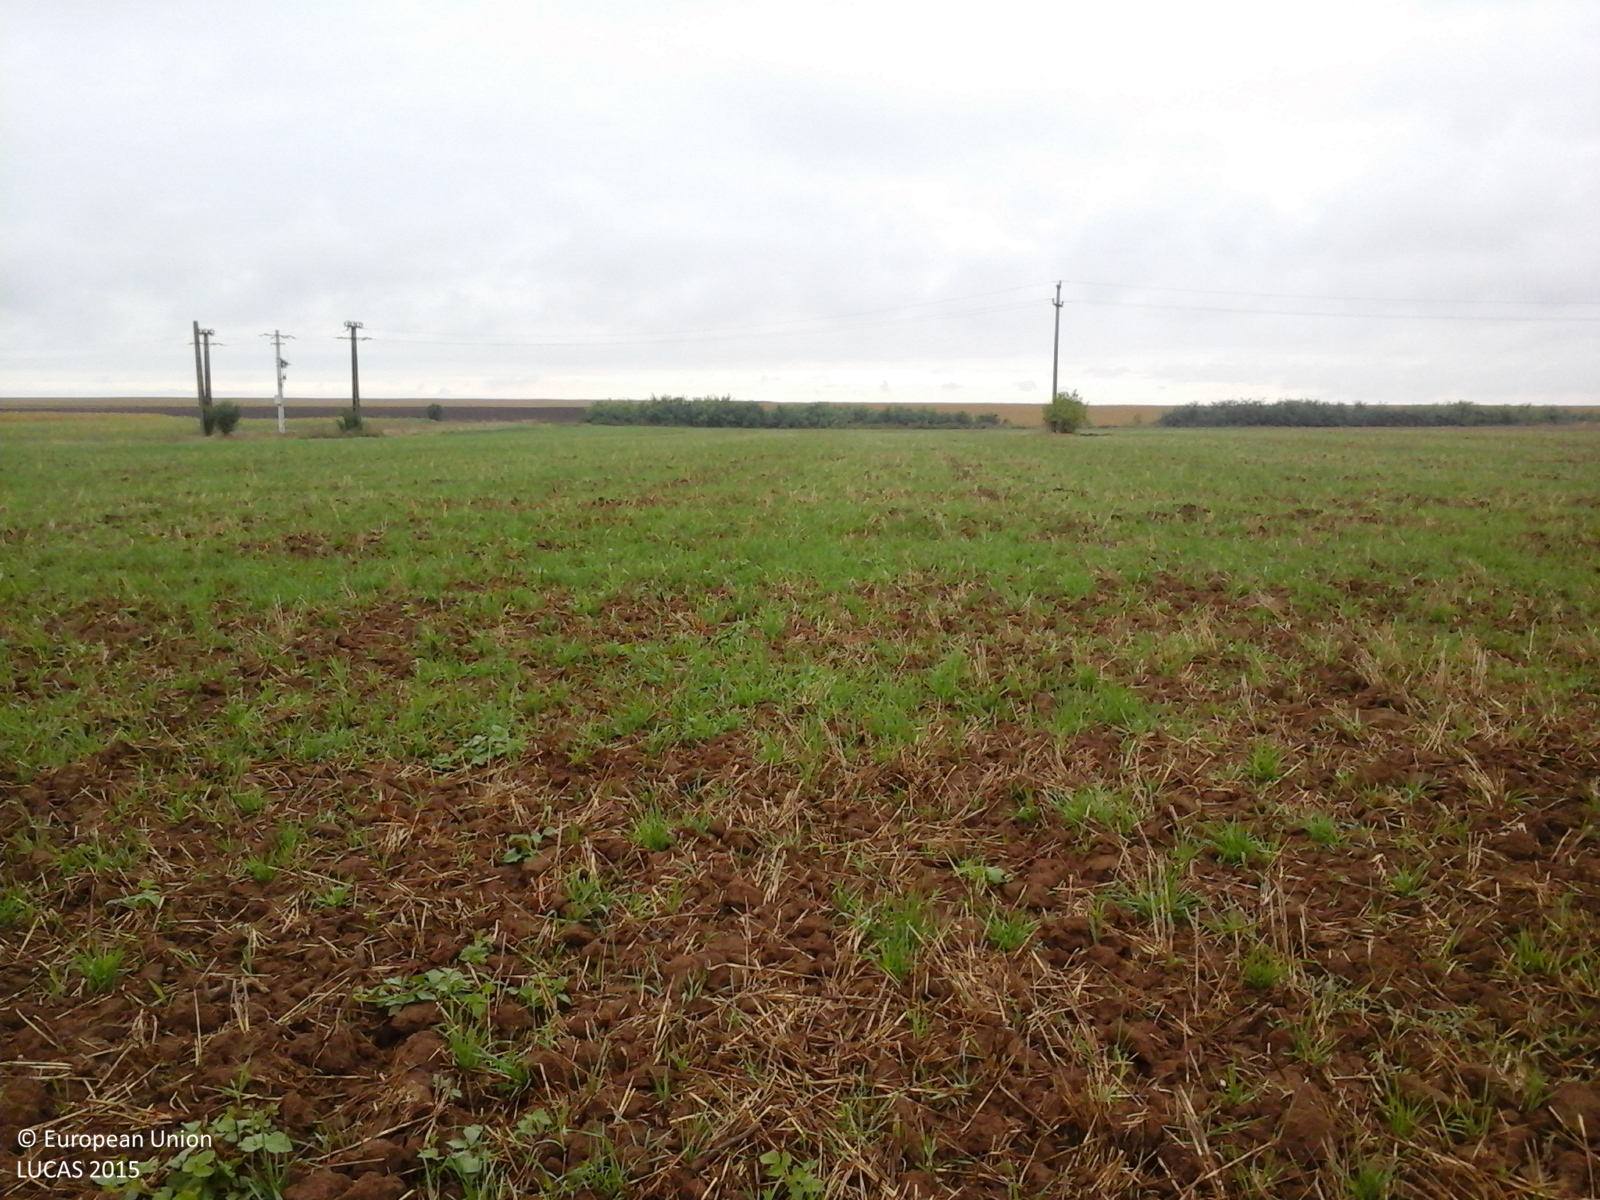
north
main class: Cropland
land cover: Common wheat
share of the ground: 25 - 50 %
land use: Agriculture (excluding fallow land and kitchen gardens)
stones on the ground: < 10 %
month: September
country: RO
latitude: 46.9561
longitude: 21.7515
